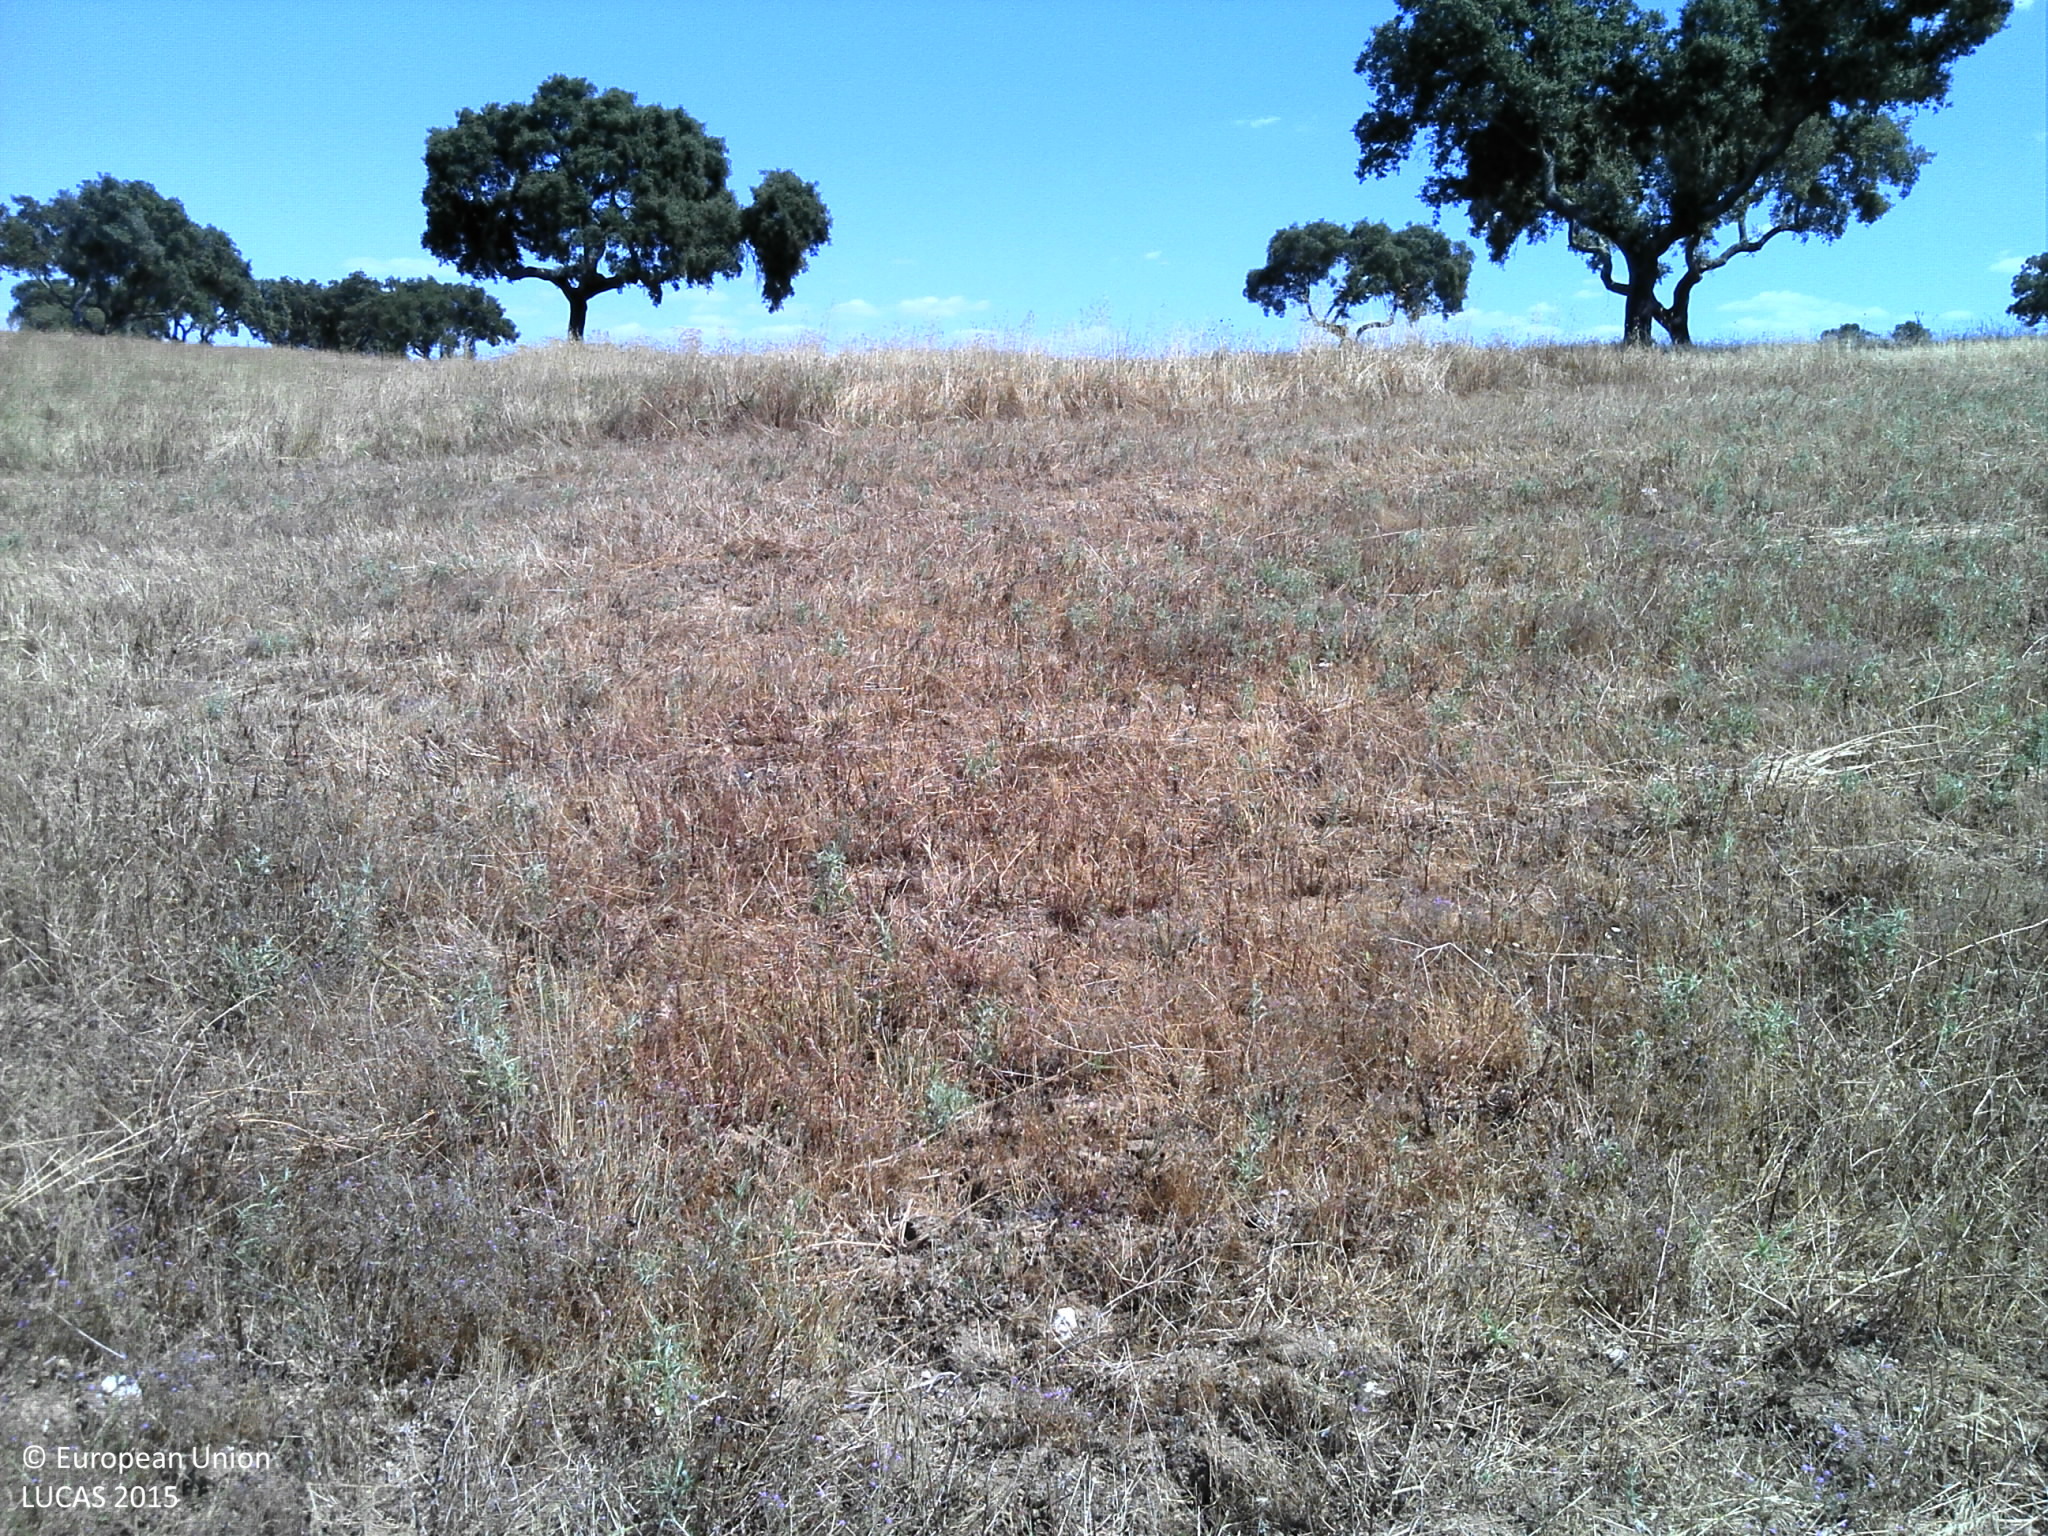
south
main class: Grassland
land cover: Grassland without tree/shrub cover
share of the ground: > 75 %
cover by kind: herbaceous plants 90 %, unconsolidated bare surface 10 %
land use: Agriculture (excluding fallow land and kitchen gardens)
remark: Harvested field
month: June
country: PT
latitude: 37.7840
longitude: -8.3266
